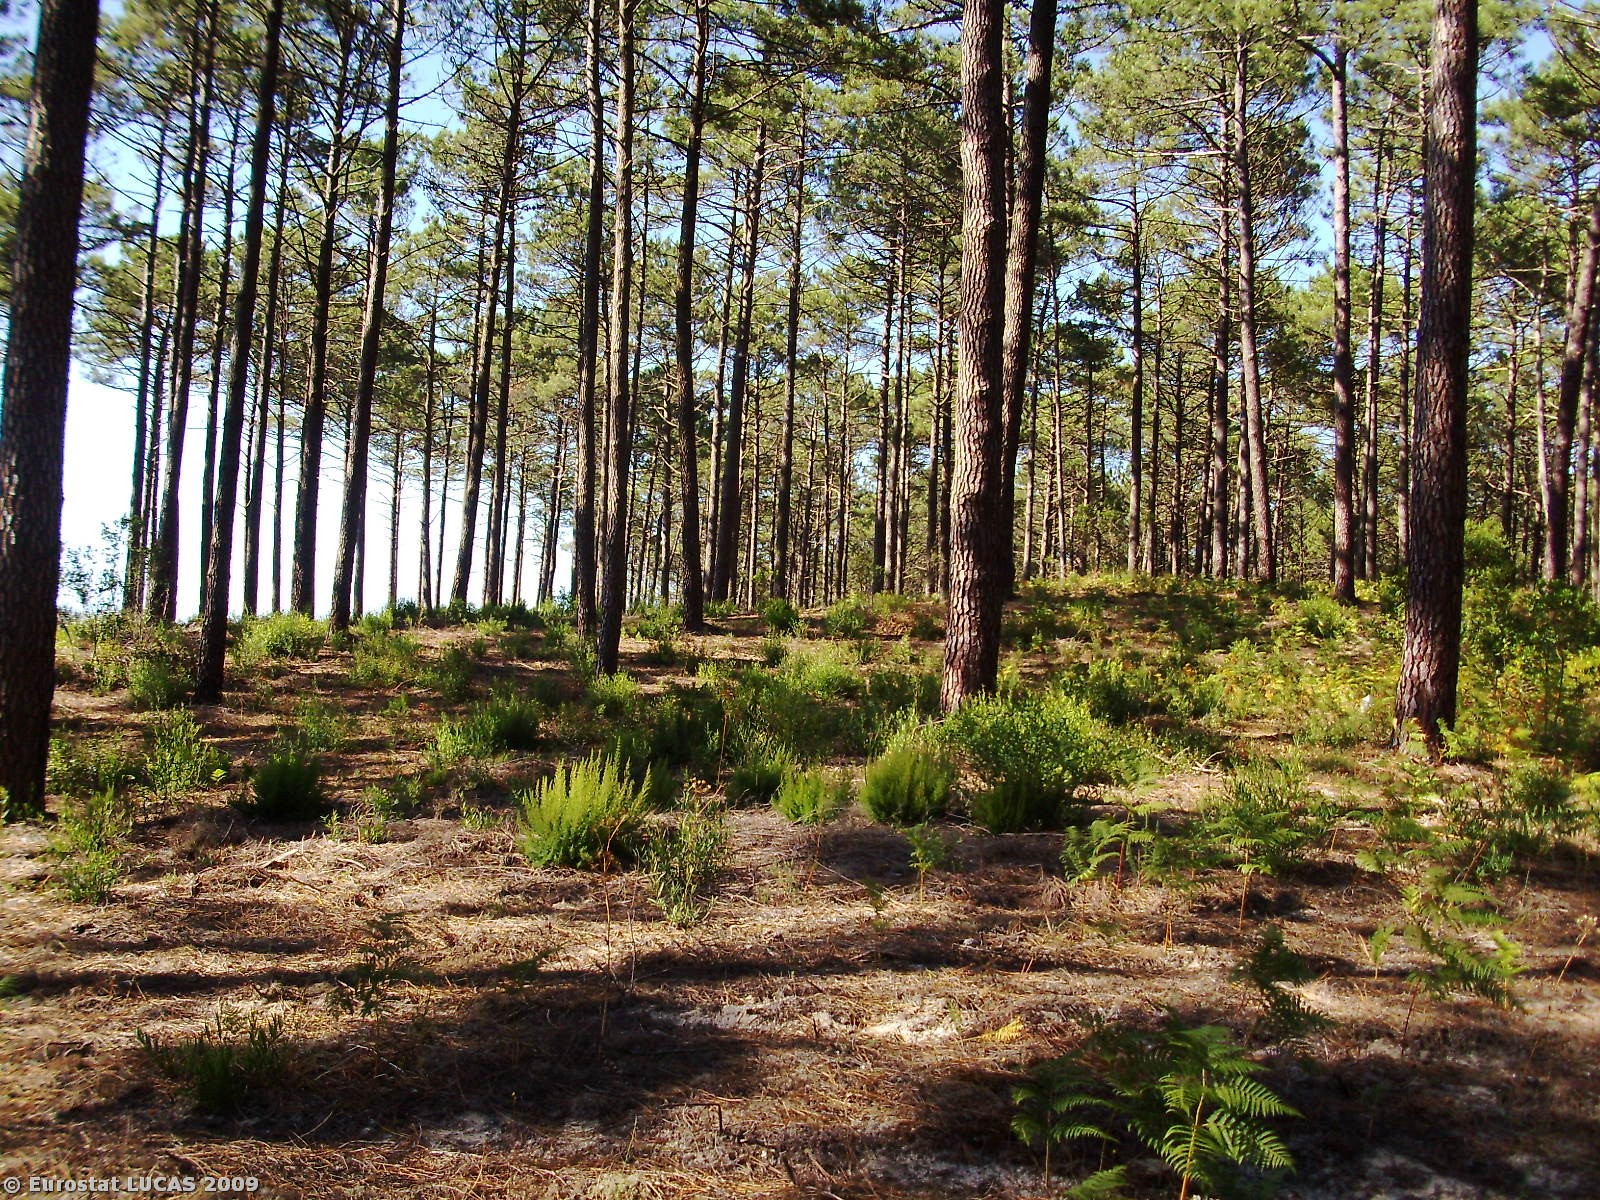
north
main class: Woodland
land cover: Coniferous woodland
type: coniferous forest of the mediterranean region
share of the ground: > 75 %
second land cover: Shrubland with sparse tree cover
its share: 10 - 25 %
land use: Forestry
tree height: > 5 m
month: July
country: PT
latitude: 39.7639
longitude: -8.9905
